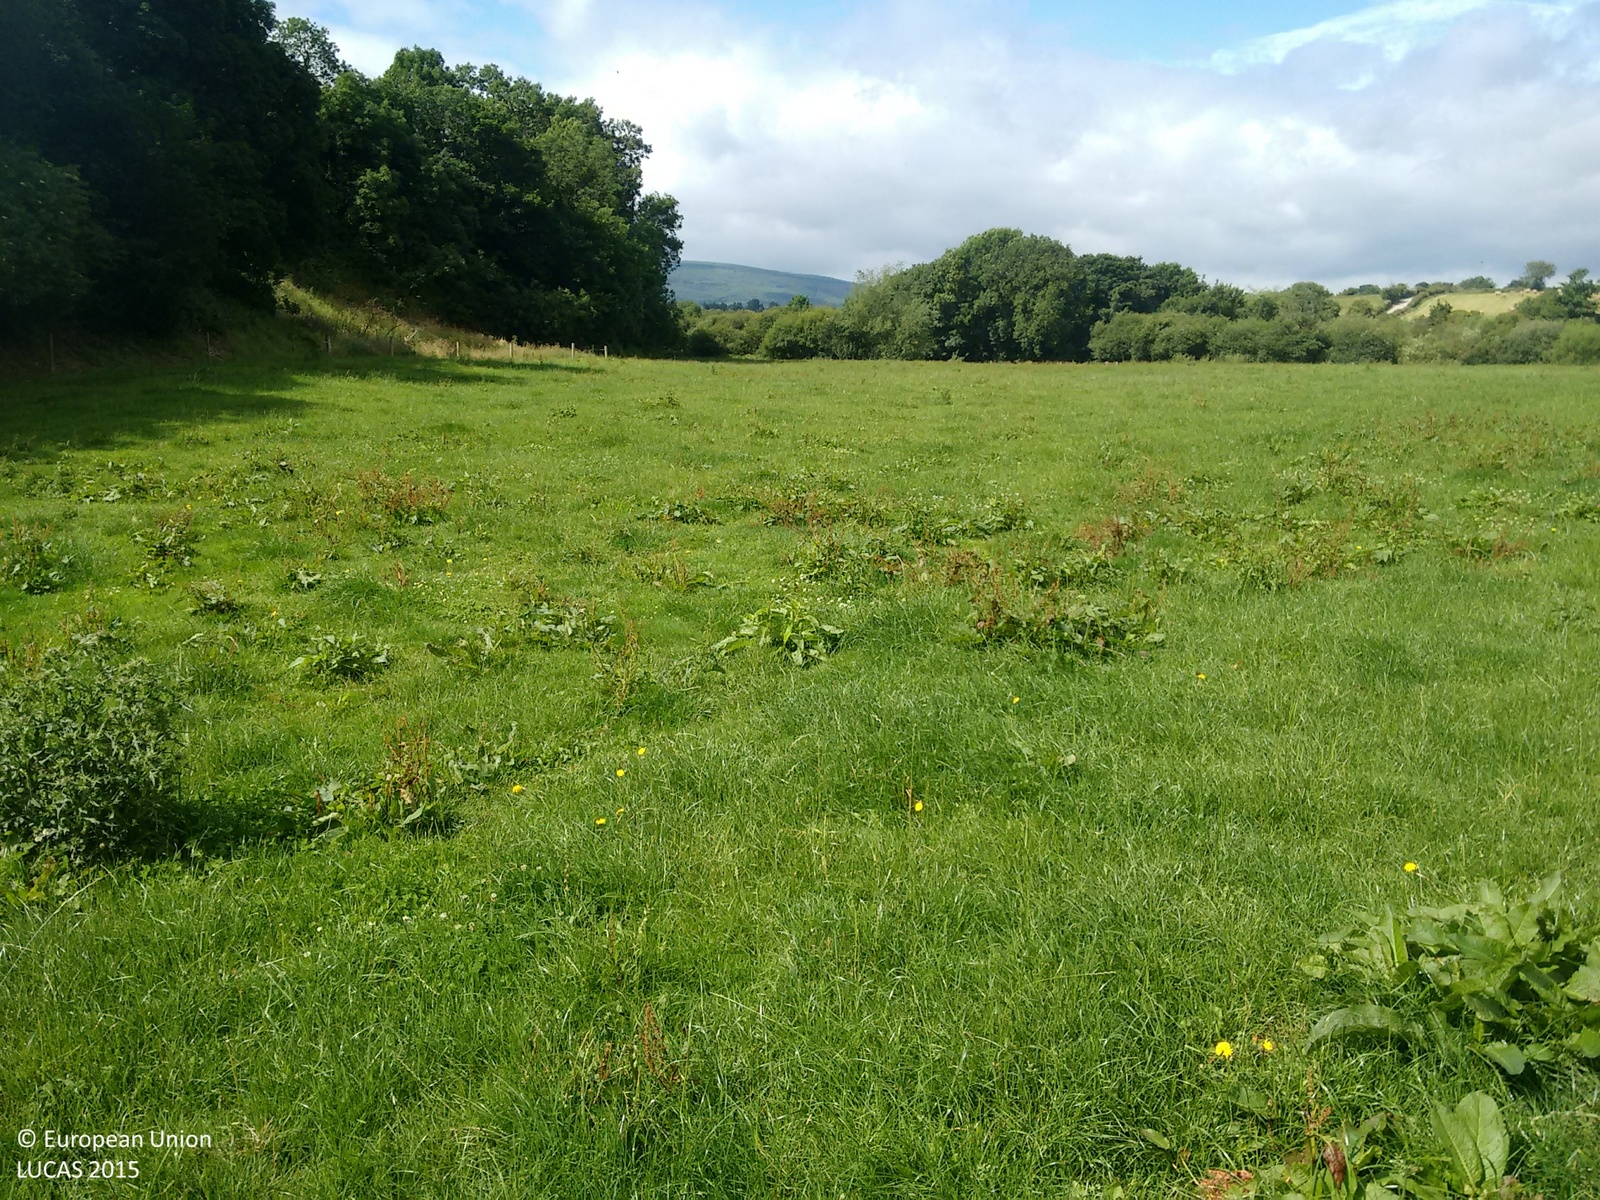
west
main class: Grassland
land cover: Grassland without tree/shrub cover
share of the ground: > 75 %
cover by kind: herbaceous plants 100 %
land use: Agriculture (excluding fallow land and kitchen gardens)
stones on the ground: < 10 %
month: July
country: IE
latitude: 52.1506
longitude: -8.4462
